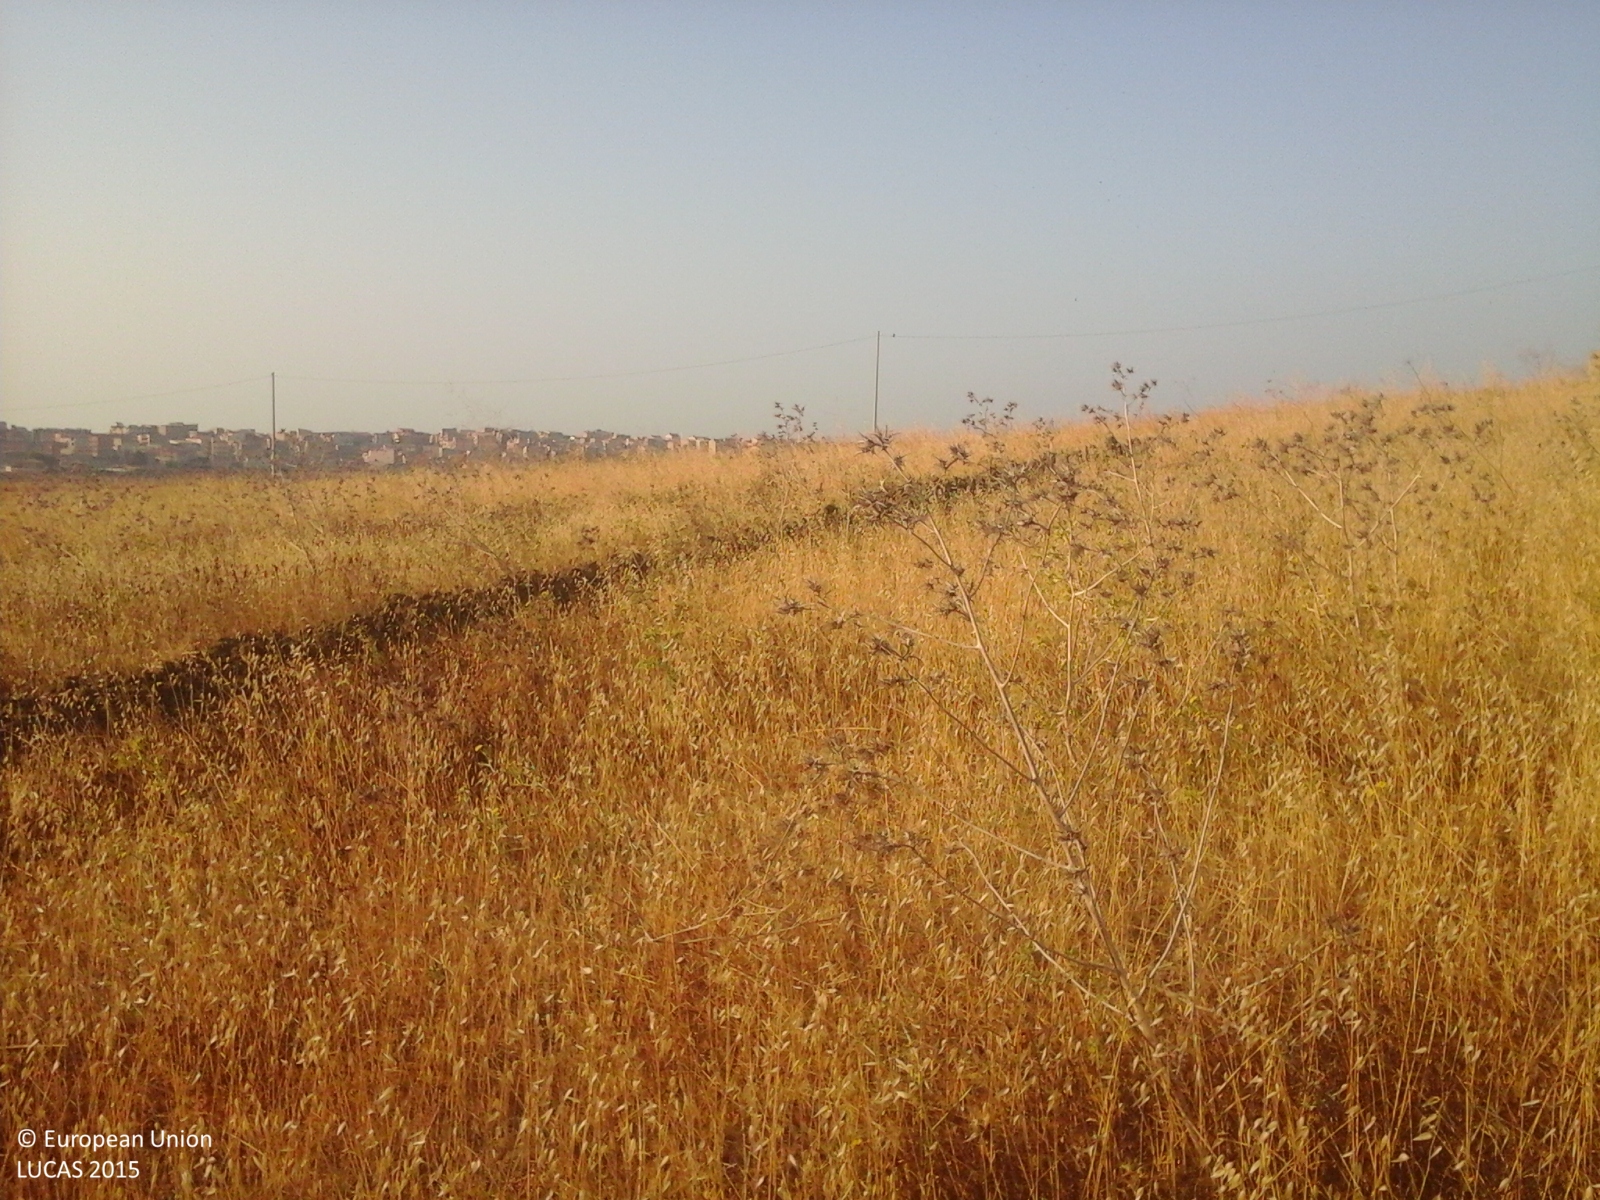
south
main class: Grassland
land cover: Spontaneously vegetated surfaces
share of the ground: > 75 %
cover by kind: herbaceous plants 100 %
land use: Fallow land
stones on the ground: > 50 %
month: July
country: IT
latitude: 37.1205
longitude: 13.9417
